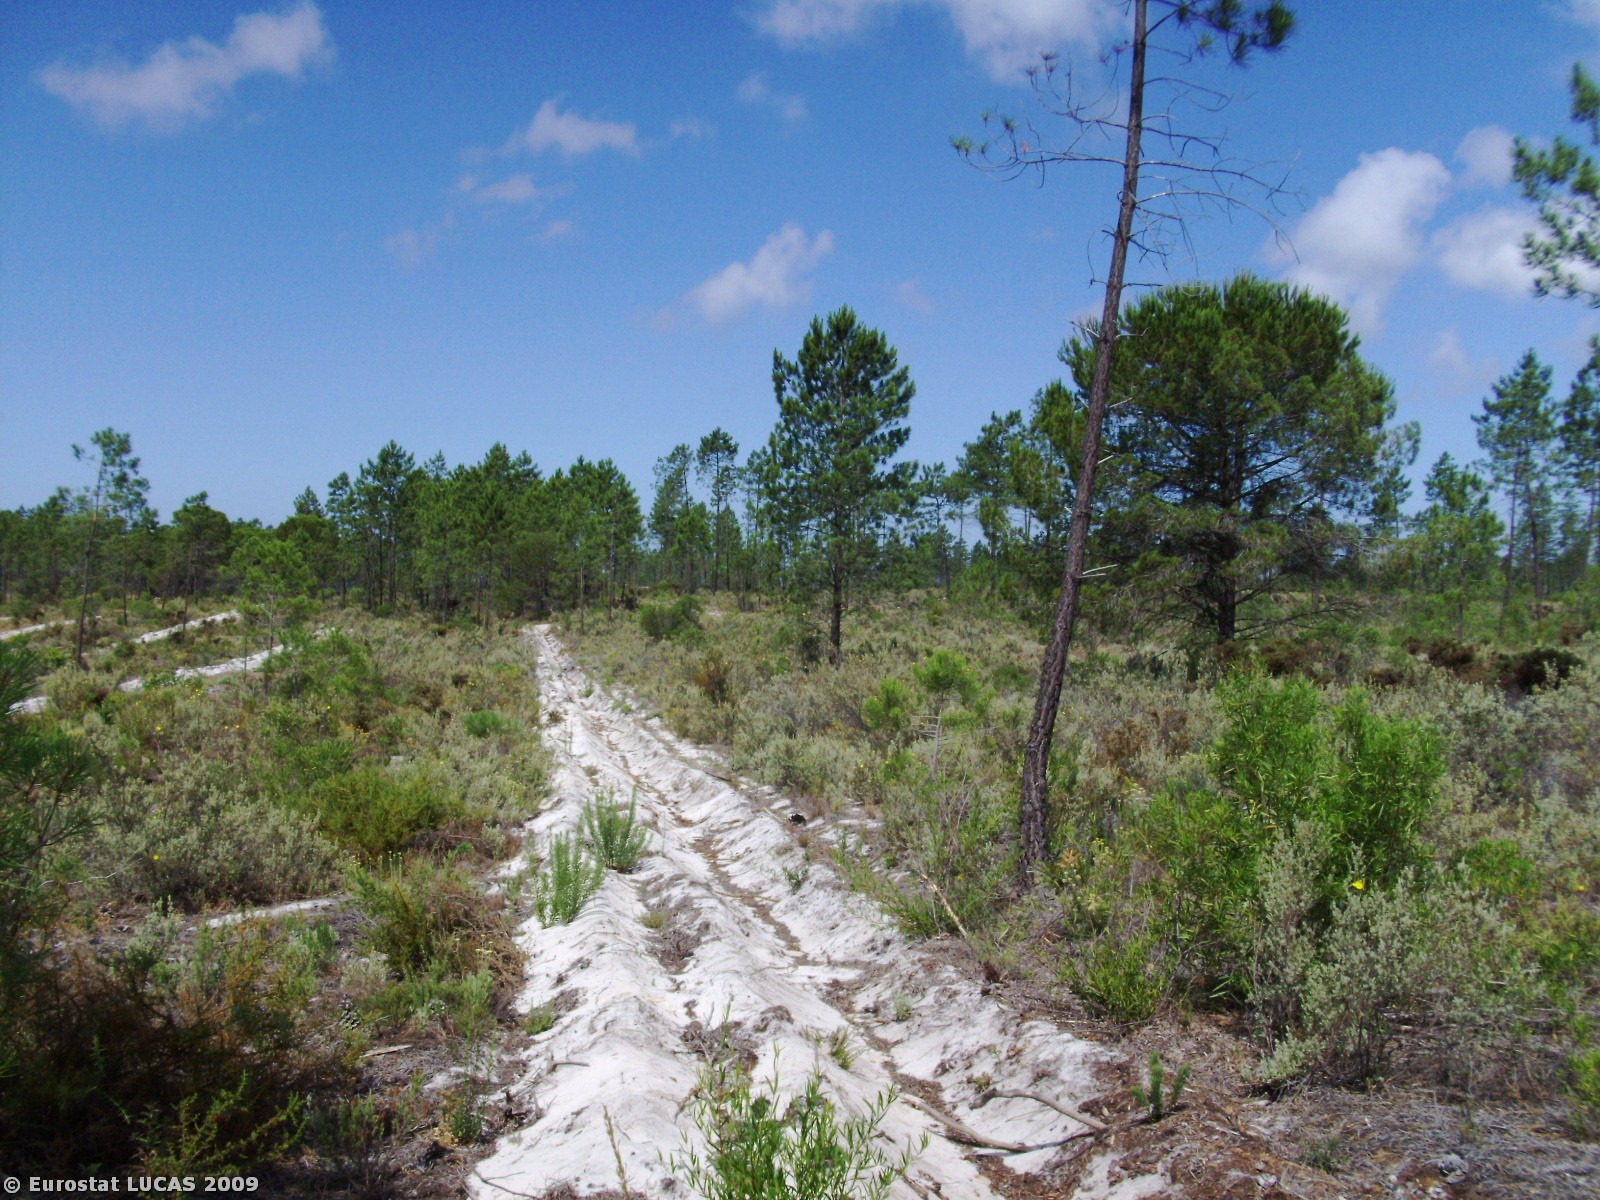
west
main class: Shrubland
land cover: Shrubland with sparse tree cover
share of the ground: 50 - 75 %
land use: Unused
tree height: < 5 m
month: June
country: PT
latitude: 38.3239
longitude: -8.6879
